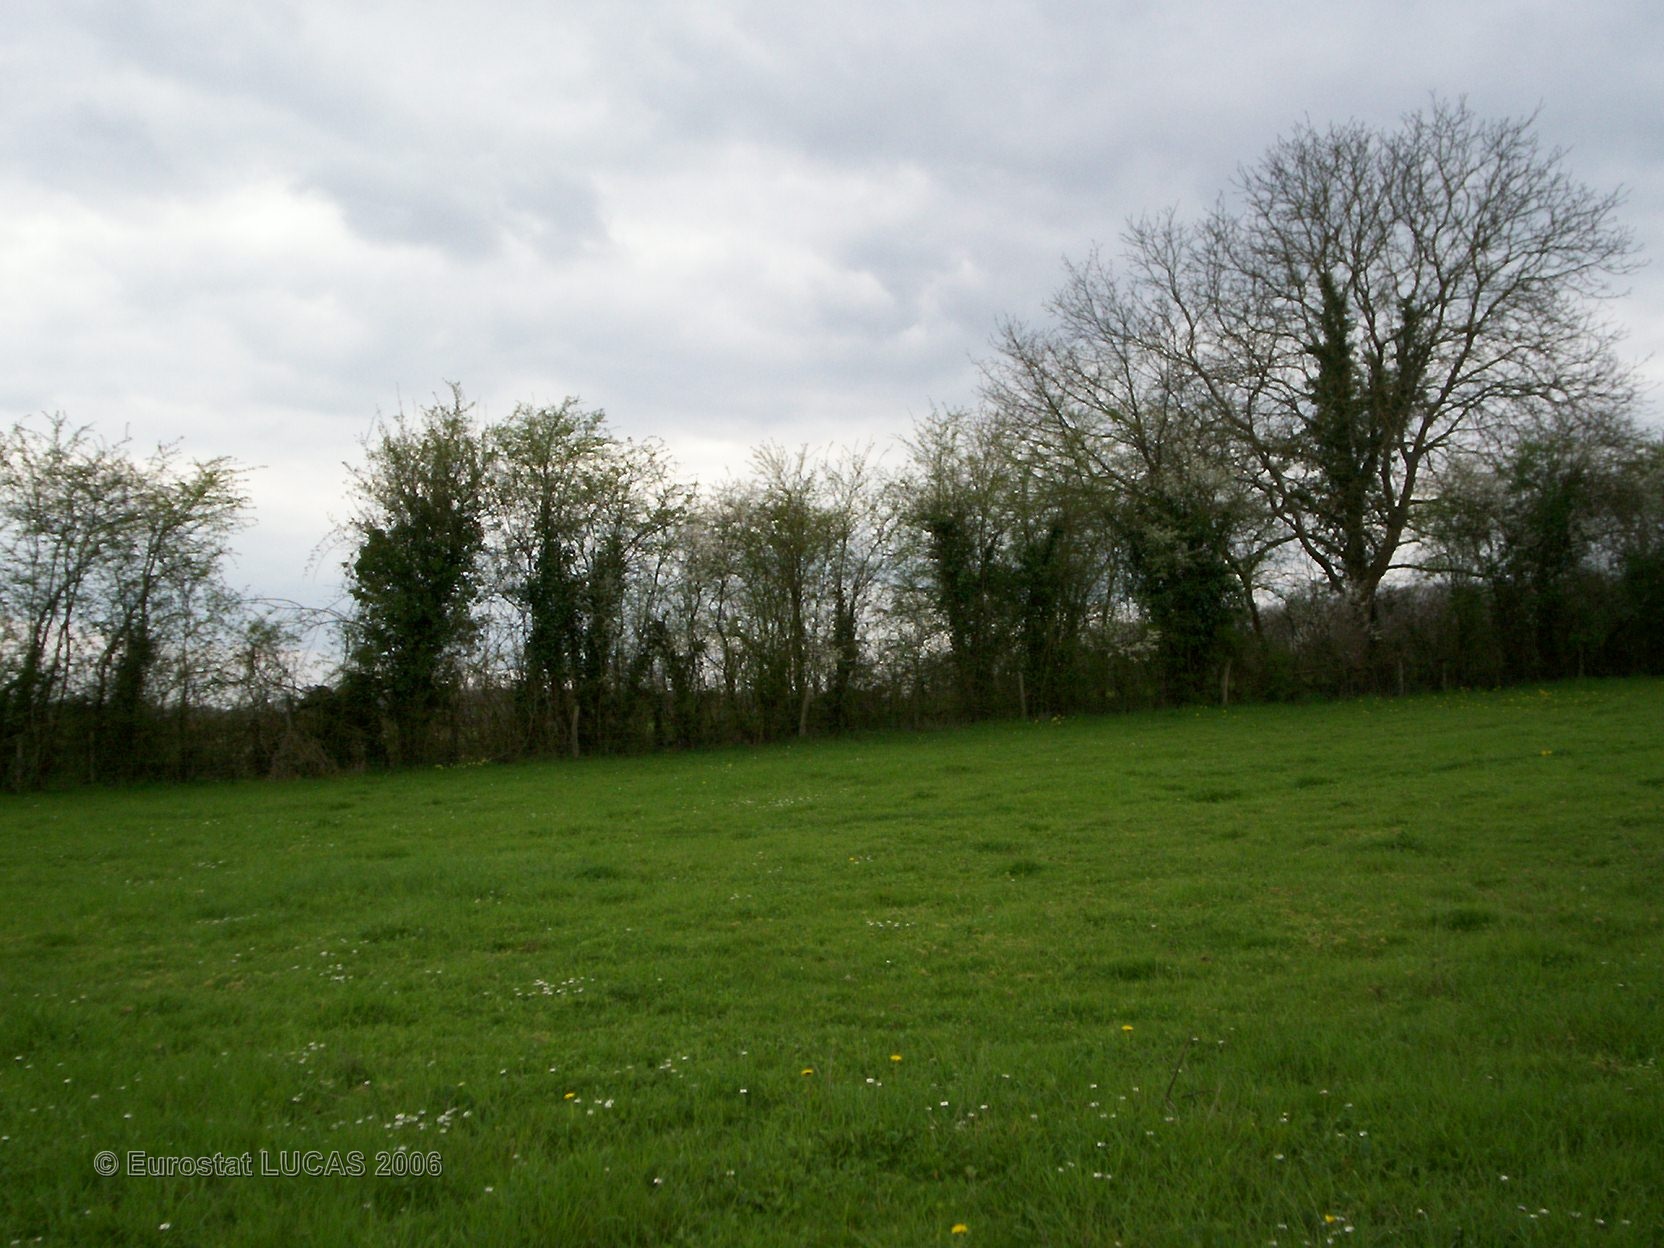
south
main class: Grassland
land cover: Grassland without tree/shrub cover
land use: Agriculture (excluding fallow land and kitchen gardens)
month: April
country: FR
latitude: 47.5867
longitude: 0.2022
